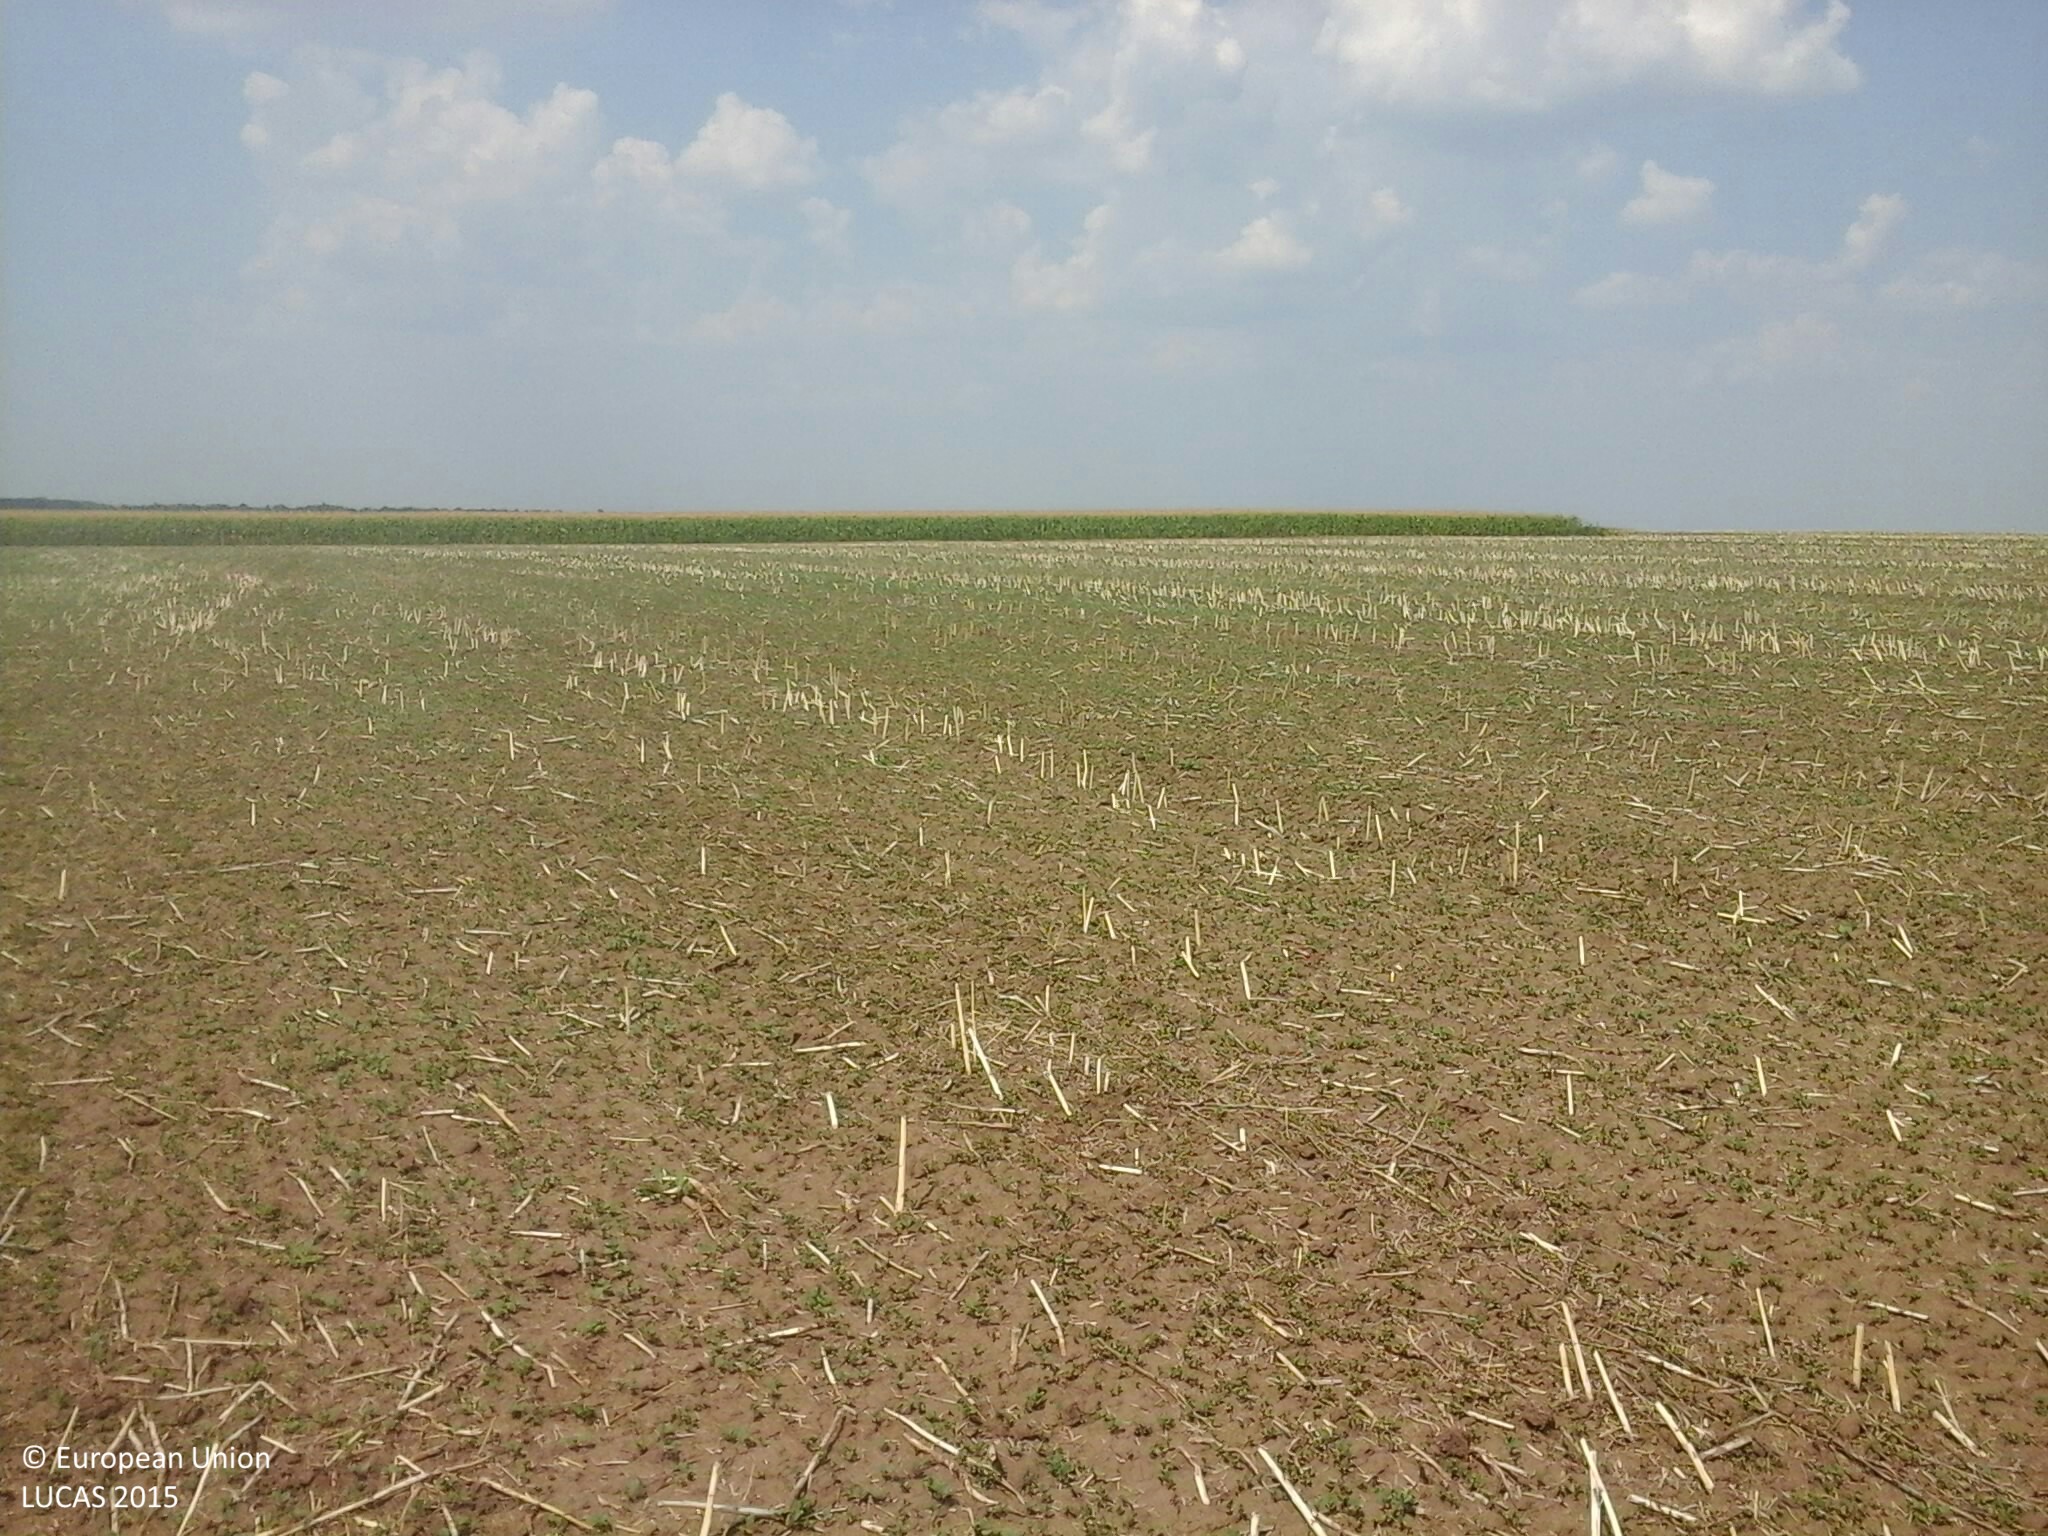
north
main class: Cropland
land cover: Rape and turnip rape
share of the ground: < 10 %
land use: Agriculture (excluding fallow land and kitchen gardens)
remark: Harvested field
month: August
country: HU
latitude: 46.8837
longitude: 18.2381
